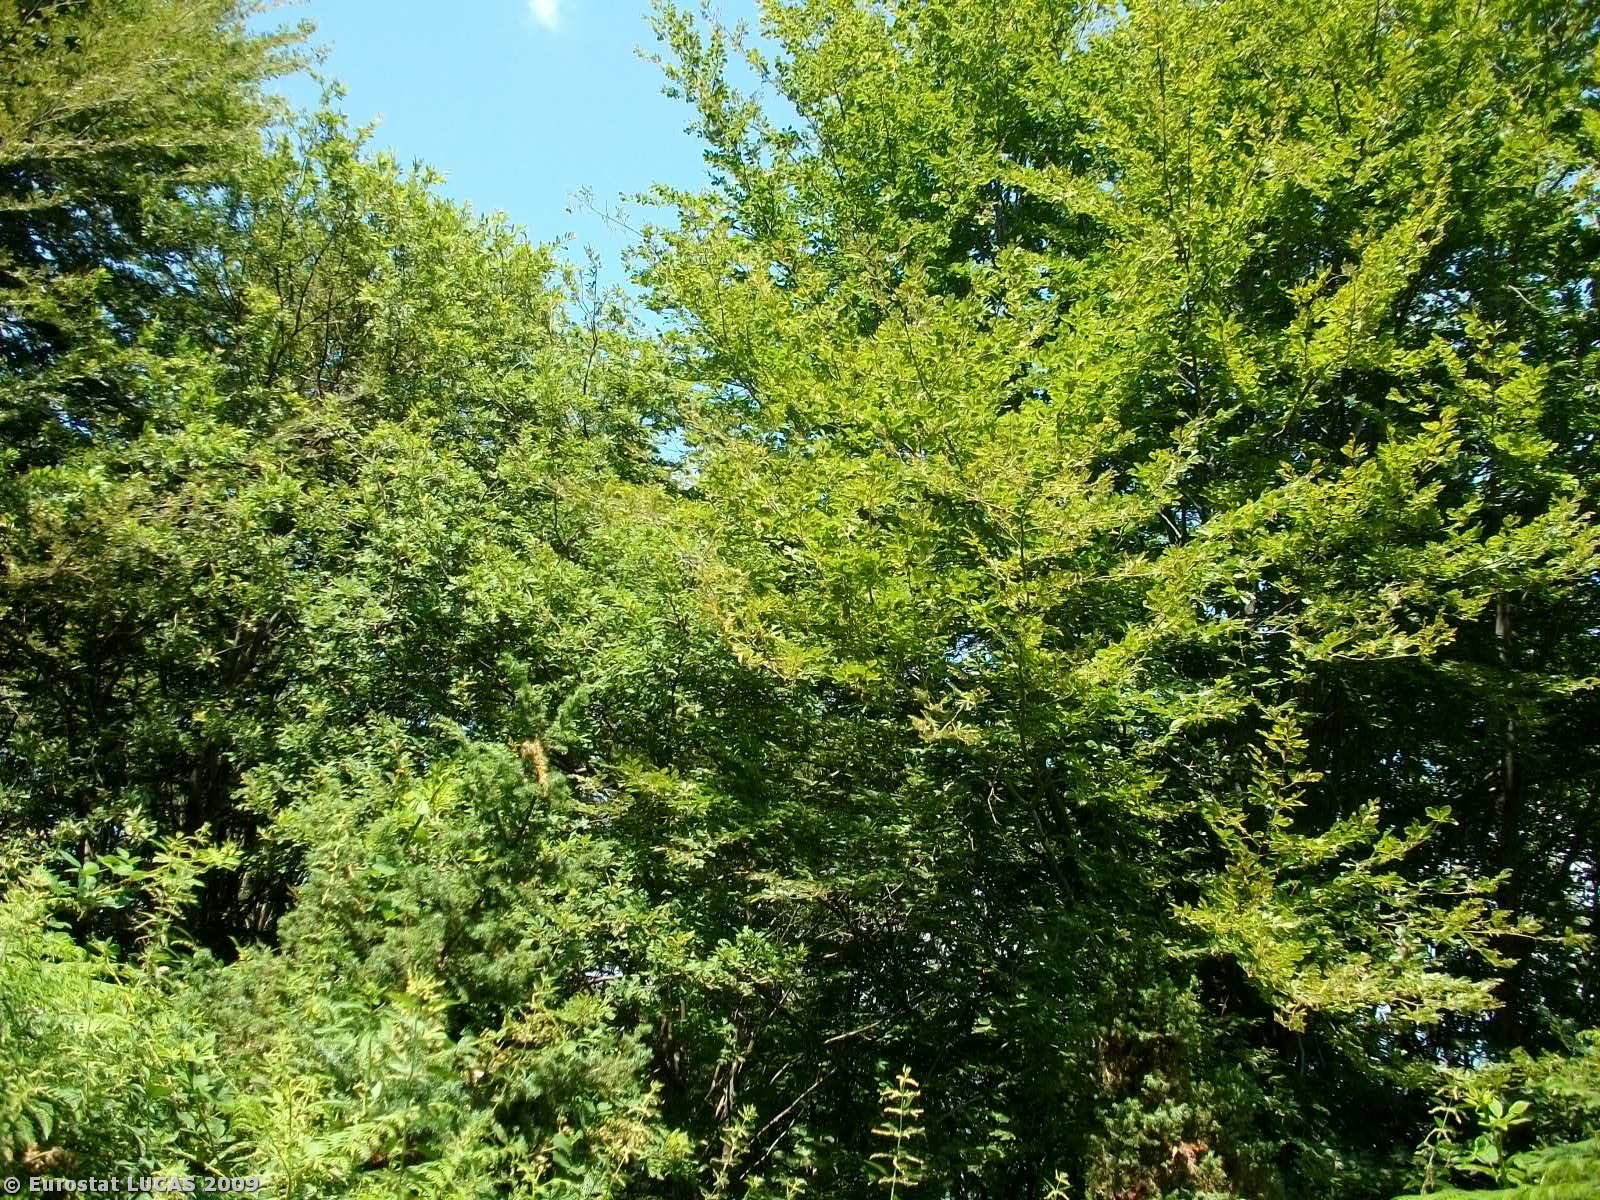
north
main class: Woodland
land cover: Broadleaved woodland
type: beech forest
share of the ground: > 75 %
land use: Forestry
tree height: > 5 m
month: August
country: GR
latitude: 41.2987
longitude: 24.2080
